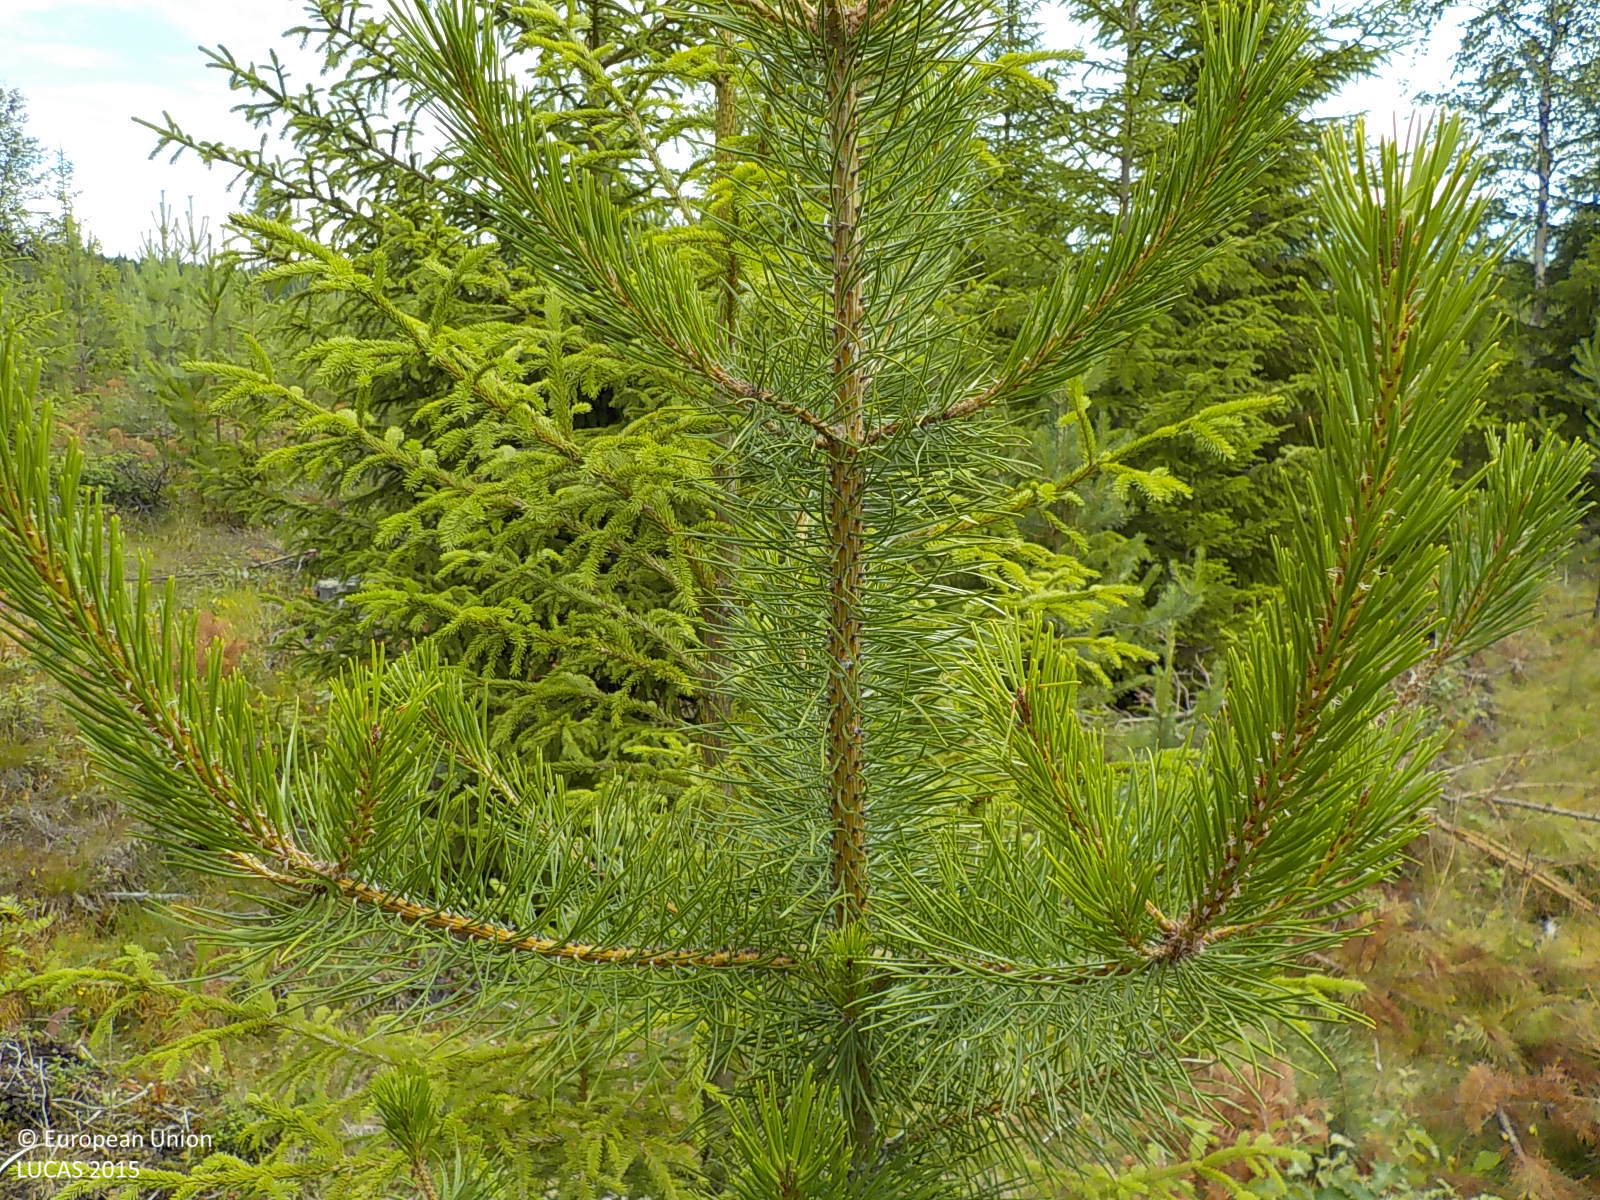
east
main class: Woodland
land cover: Pine dominated coniferous woodland
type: boreal forest
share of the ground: 50 - 75 %
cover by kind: coniferous forest trees 50 %, herbaceous plants 40 %, broadleaved forest trees 5 %, shrubs 5 %
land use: Forestry
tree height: < 5 m
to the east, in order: Pine dominated coniferous woodland; Spontaneously vegetated surfaces; Broadleaved woodland; Paved roads, cycling and walking lanes; Broadleaved woodland; Pine dominated coniferous woodland
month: July
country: SE
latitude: 63.1977
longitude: 17.2709
